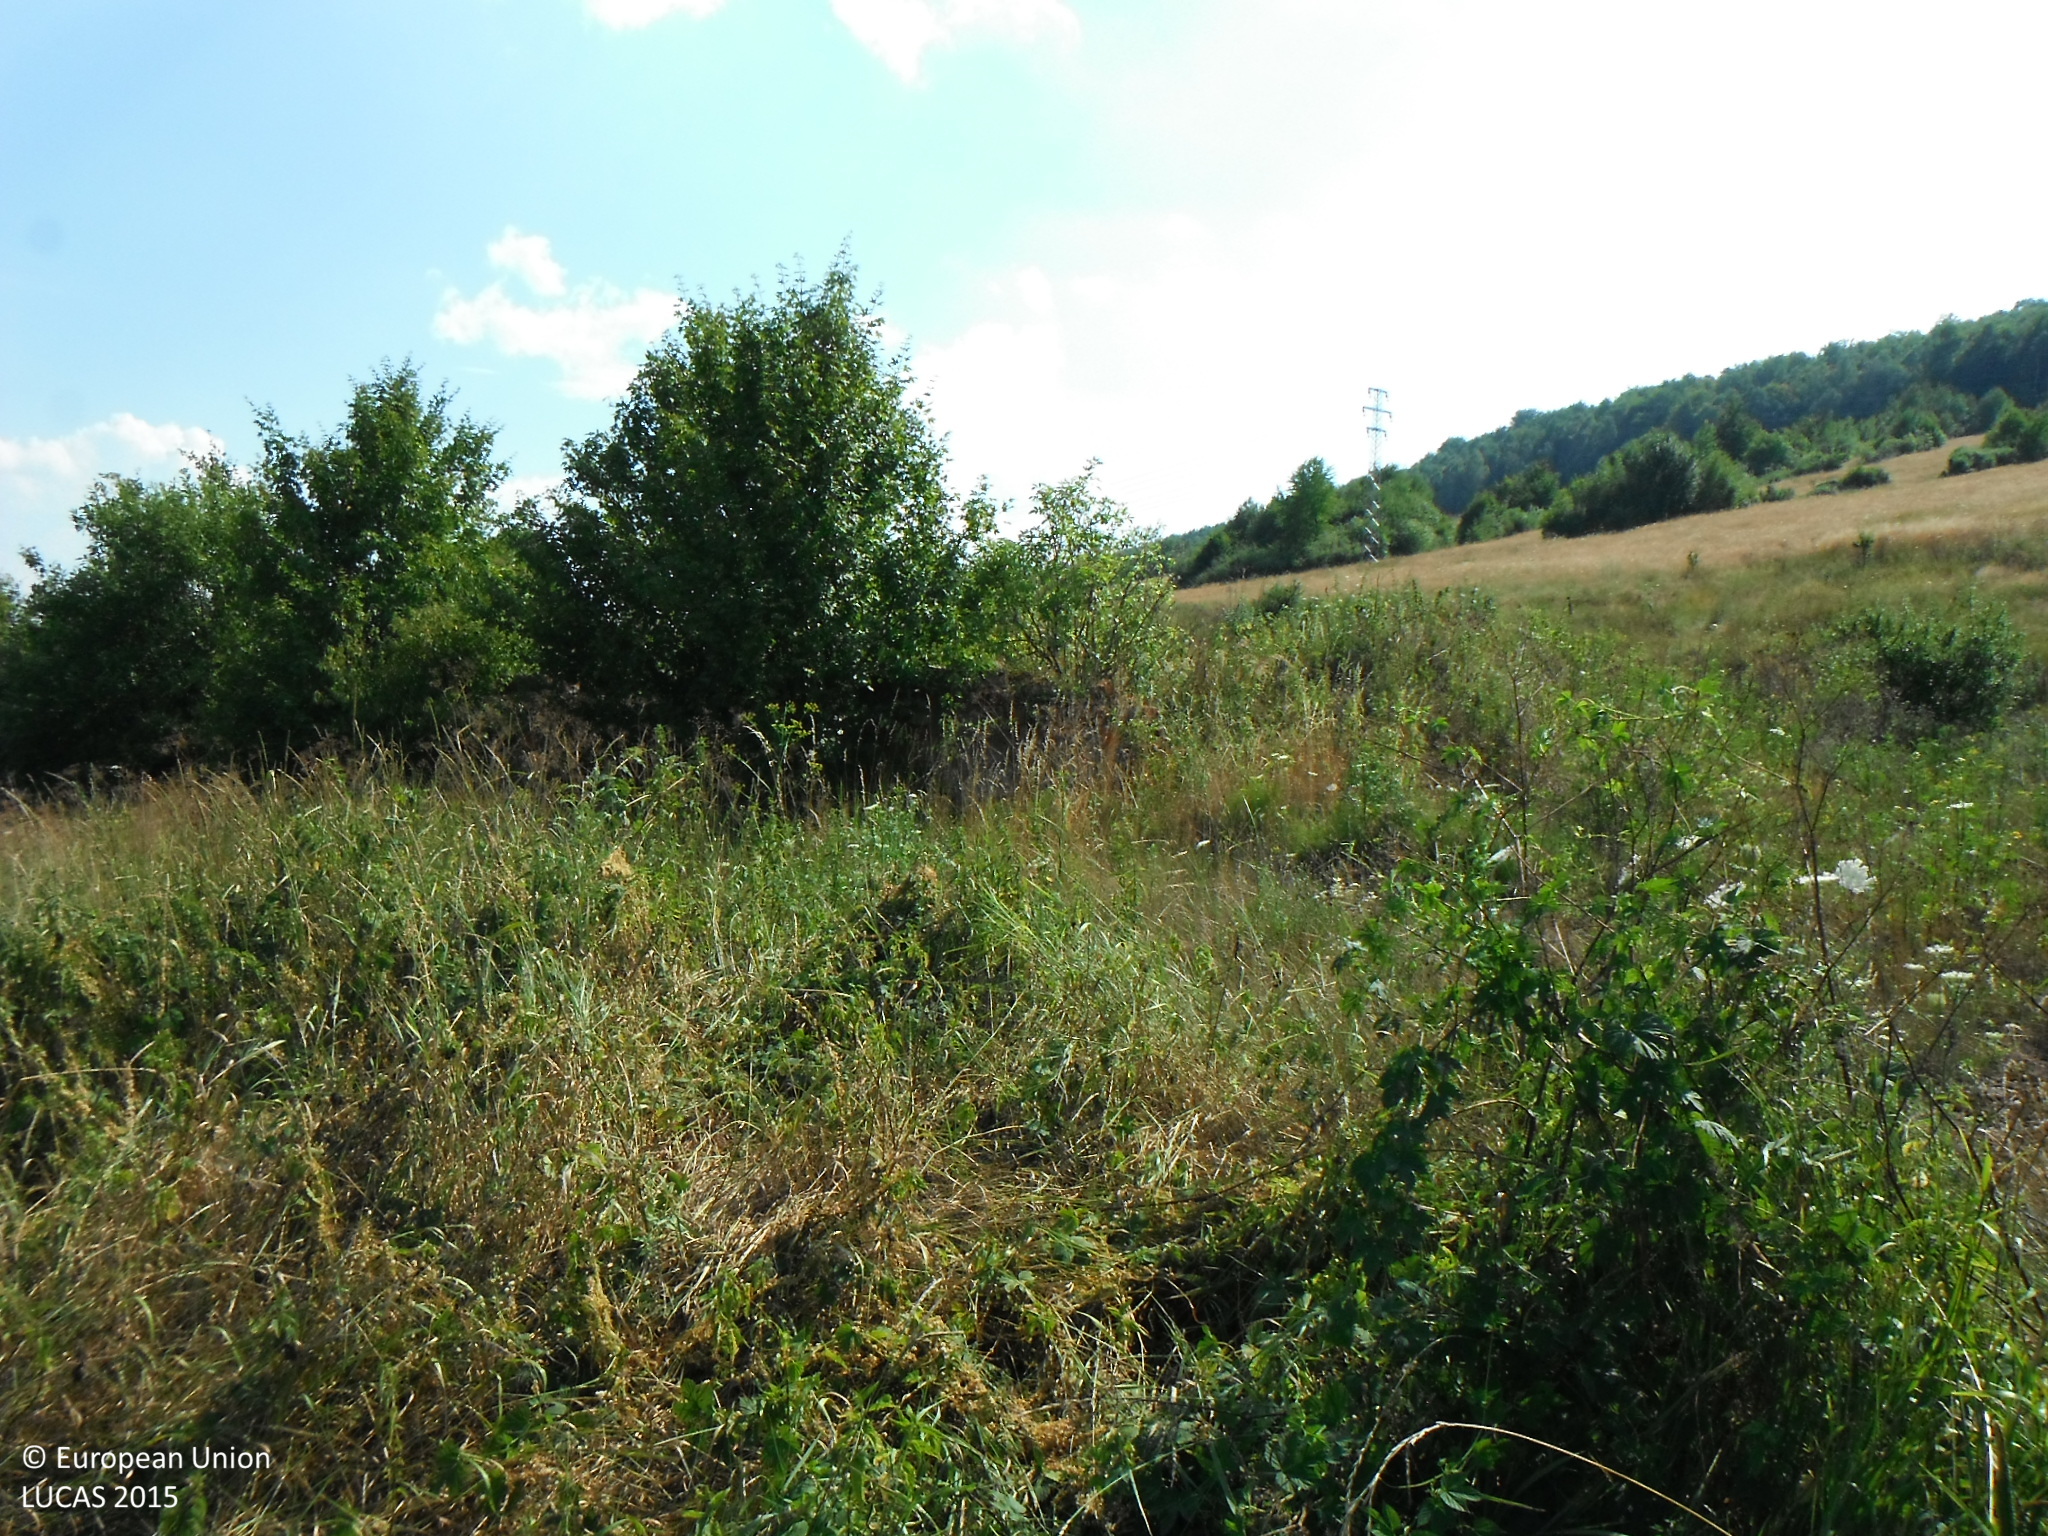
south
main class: Shrubland
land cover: Shrubland with sparse tree cover
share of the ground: 10 - 25 %
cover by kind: herbaceous plants 80 %, shrubs 15 %, broadleaved forest trees 5 %
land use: Abandoned areas
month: July
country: SK
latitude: 49.2741
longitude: 21.6655
